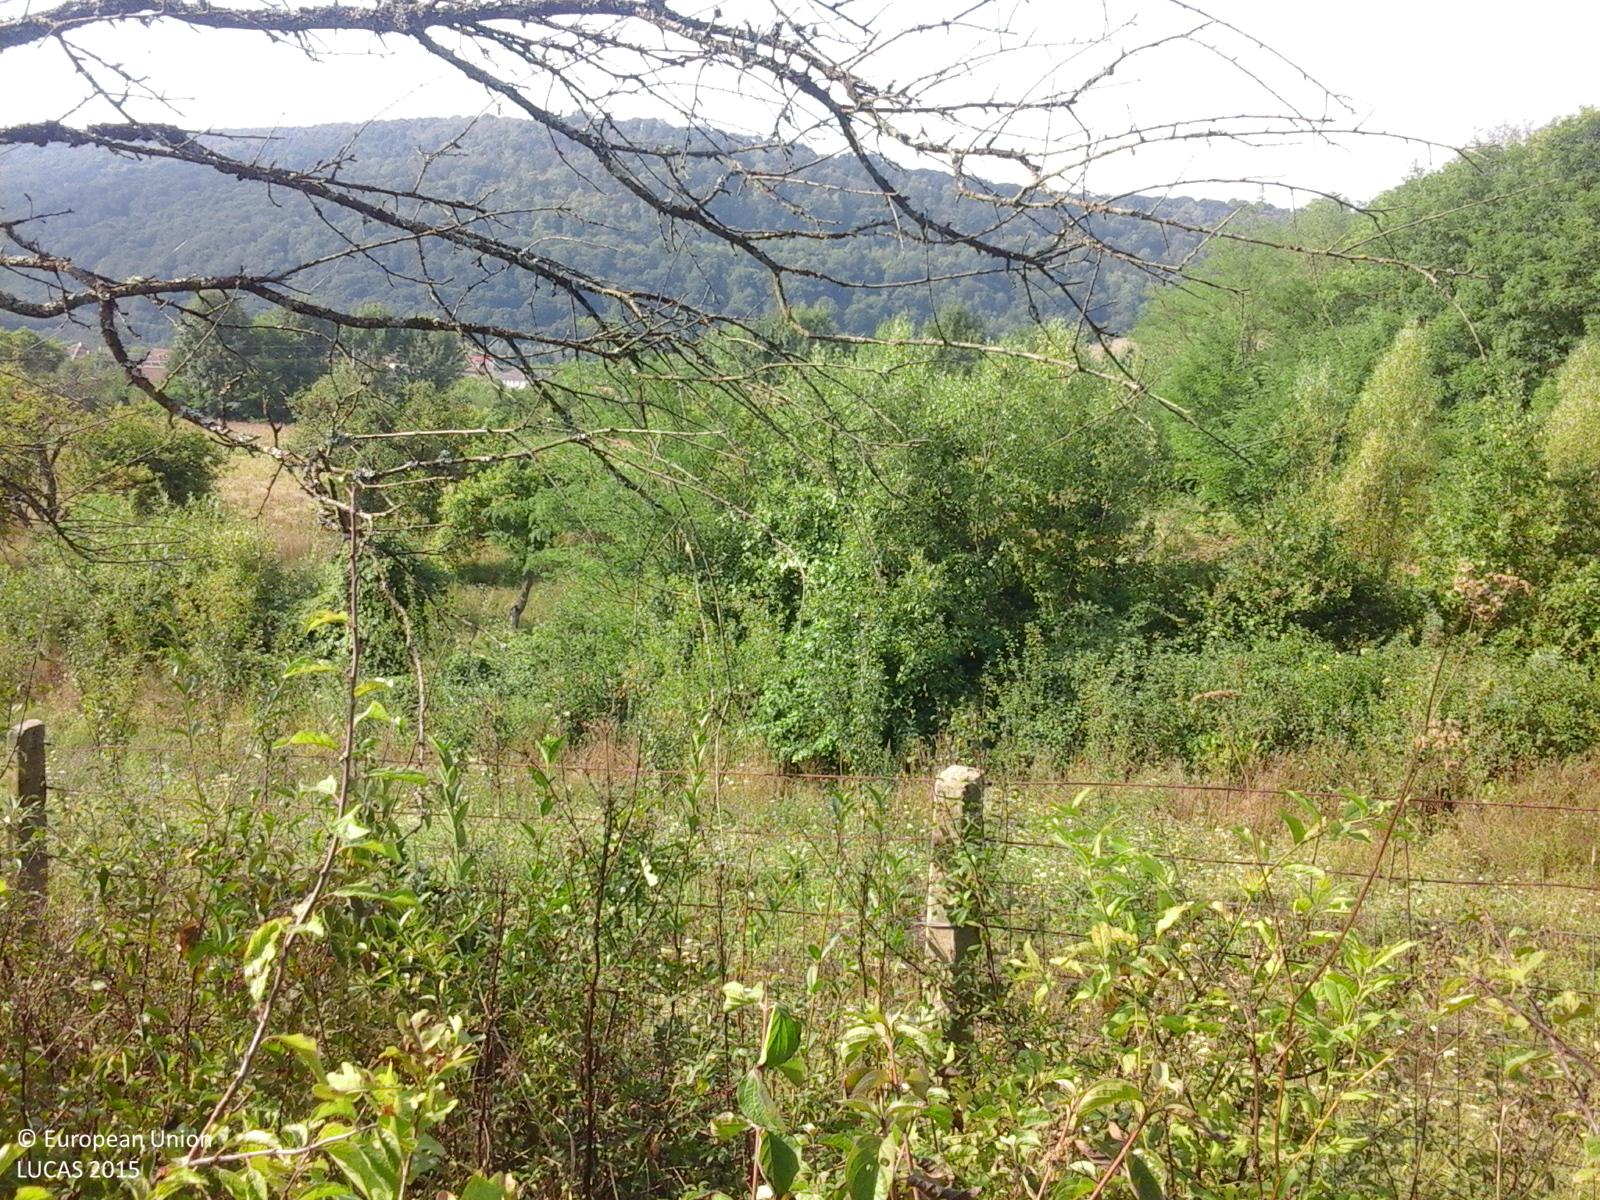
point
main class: Cropland
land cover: Apple fruit
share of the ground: 25 - 50 %
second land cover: Grassland without tree/shrub cover
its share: > 75 %
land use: Agriculture (excluding fallow land and kitchen gardens)
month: August
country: RO
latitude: 46.3837
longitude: 22.1512
